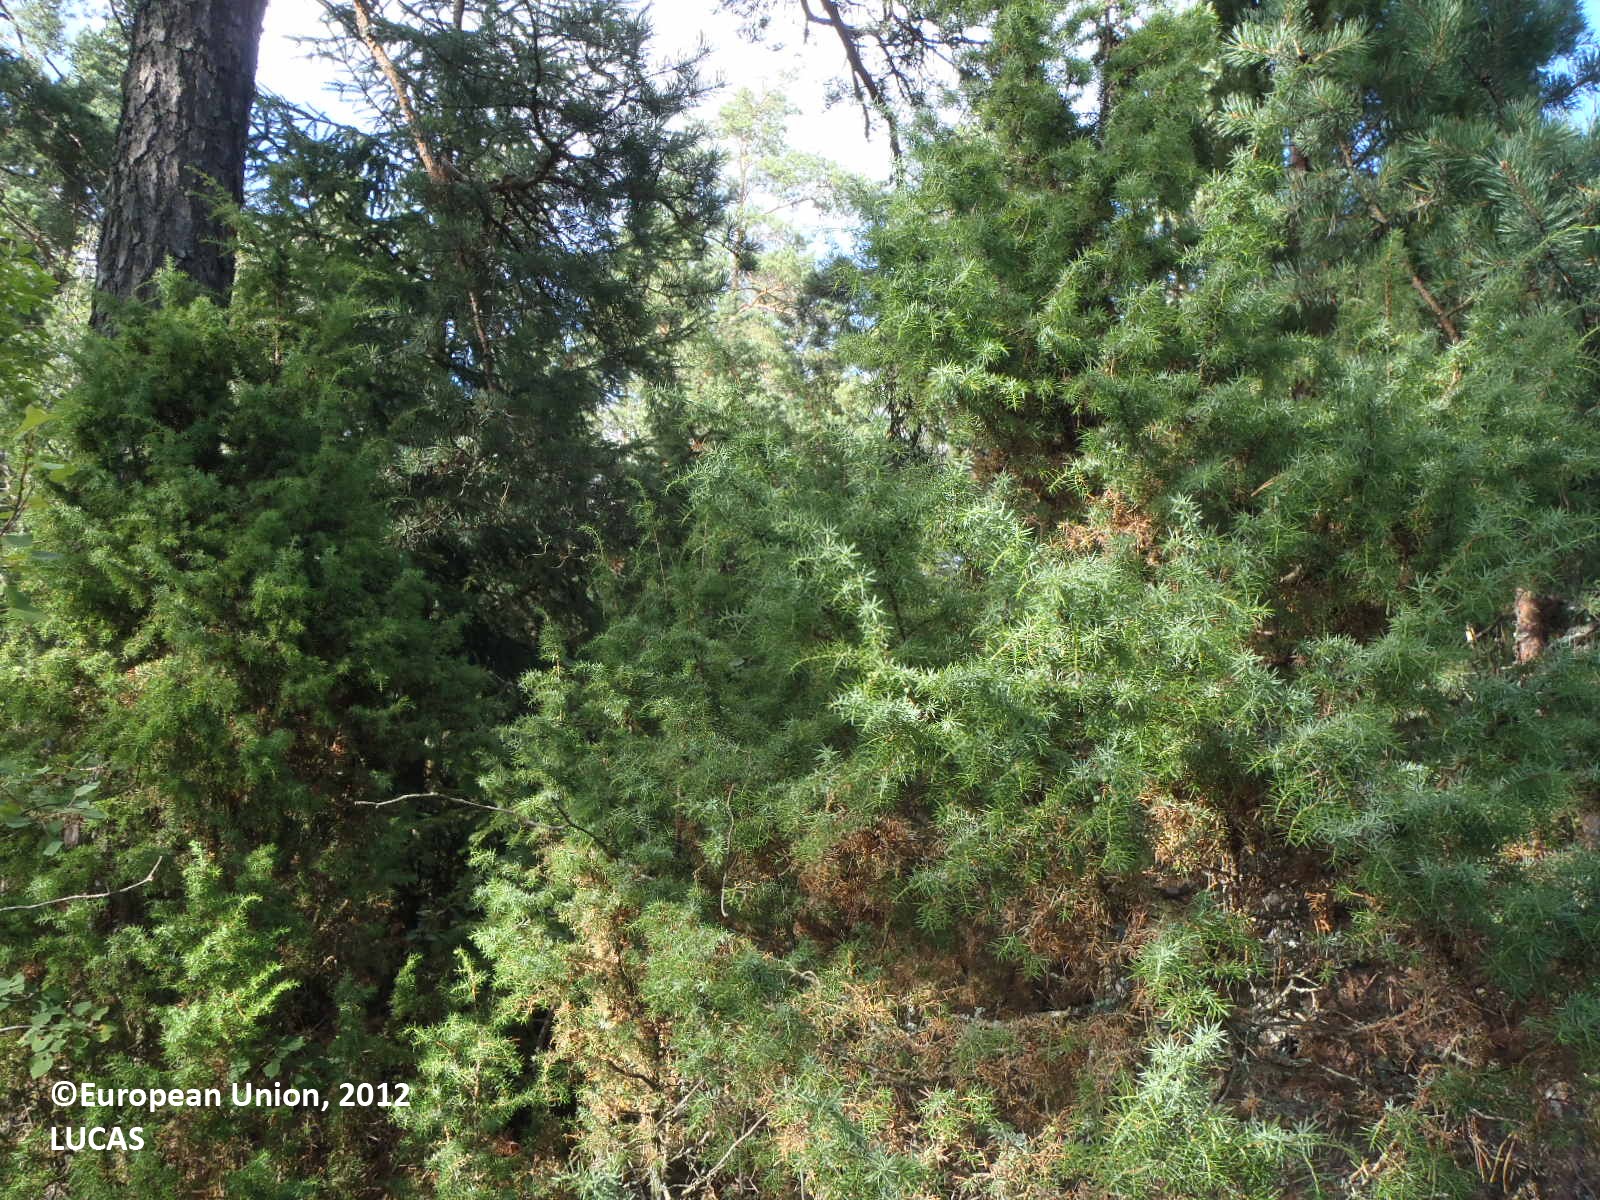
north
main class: Woodland
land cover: Pine dominated coniferous woodland
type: boreal forest
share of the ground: > 75 %
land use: Forestry
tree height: > 5 m
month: August
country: FI
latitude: 60.3308
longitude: 22.3301
